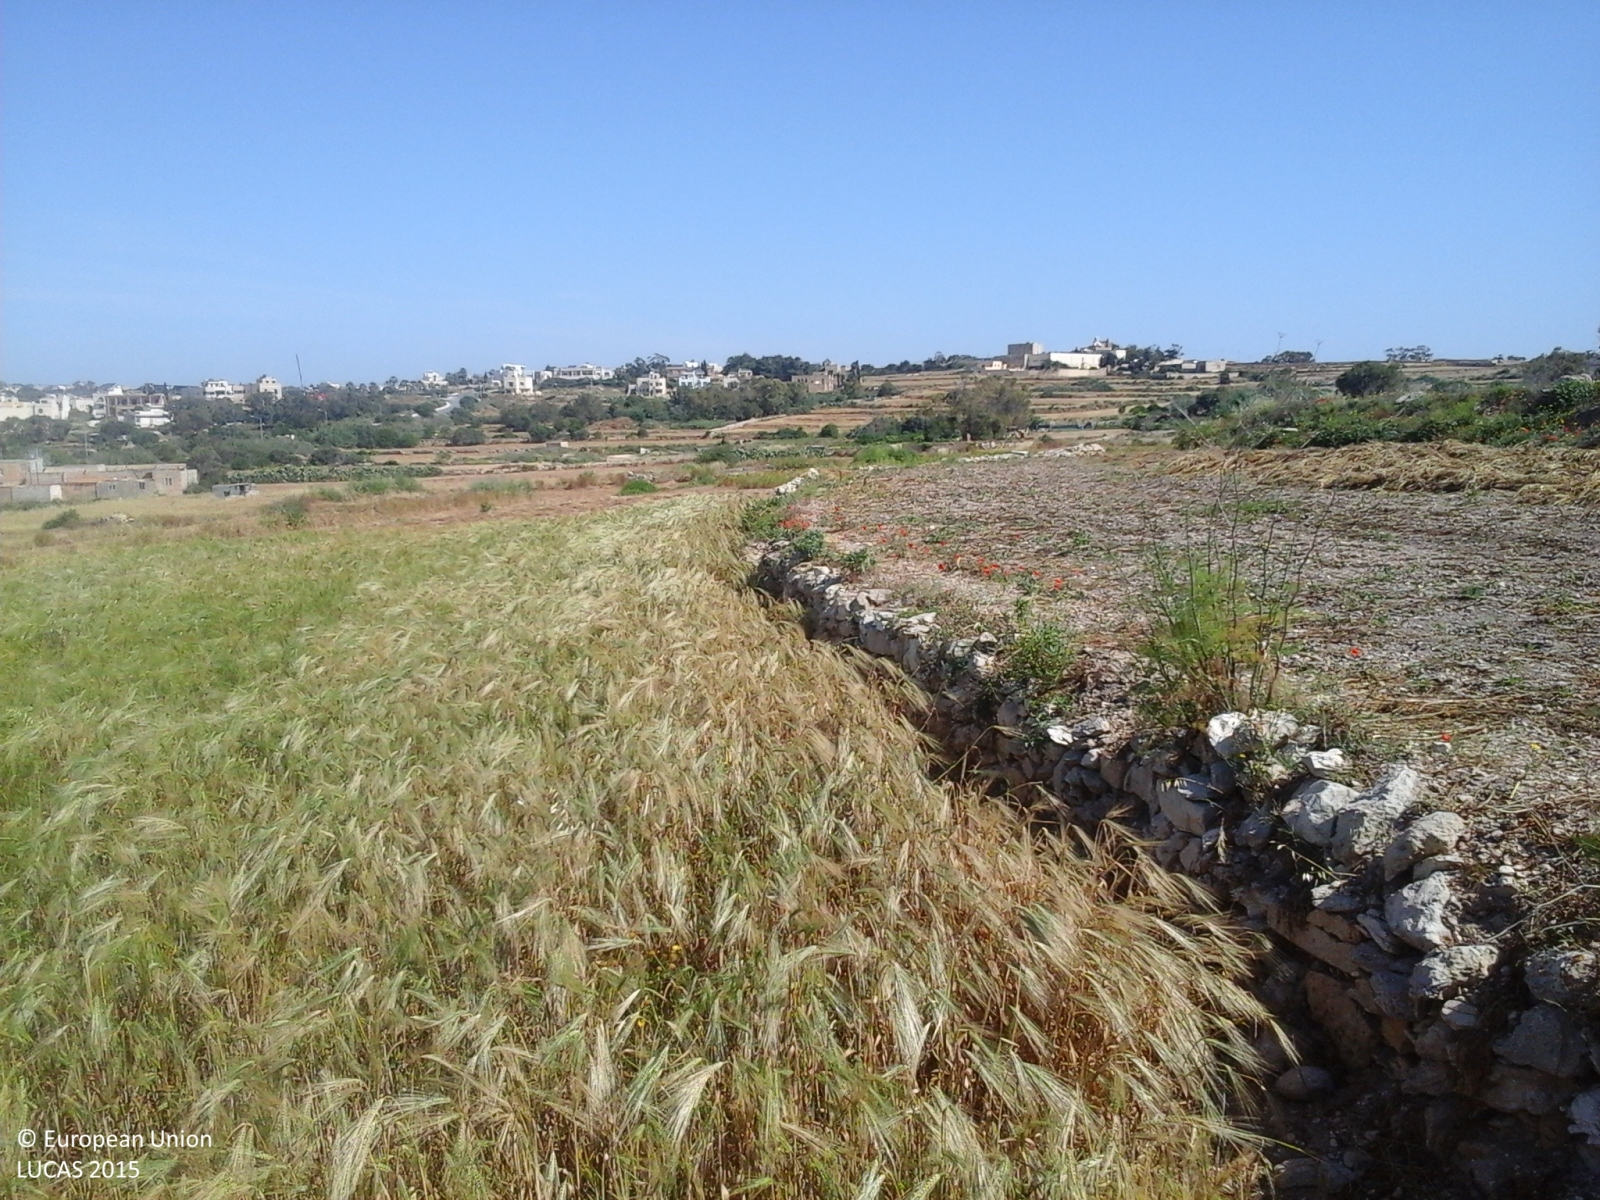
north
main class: Grassland
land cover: Grassland without tree/shrub cover
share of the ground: > 75 %
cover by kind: herbaceous plants 60 %, shrubs 5 %
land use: Abandoned areas
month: May
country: MT
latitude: 35.8368
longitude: 14.5521
